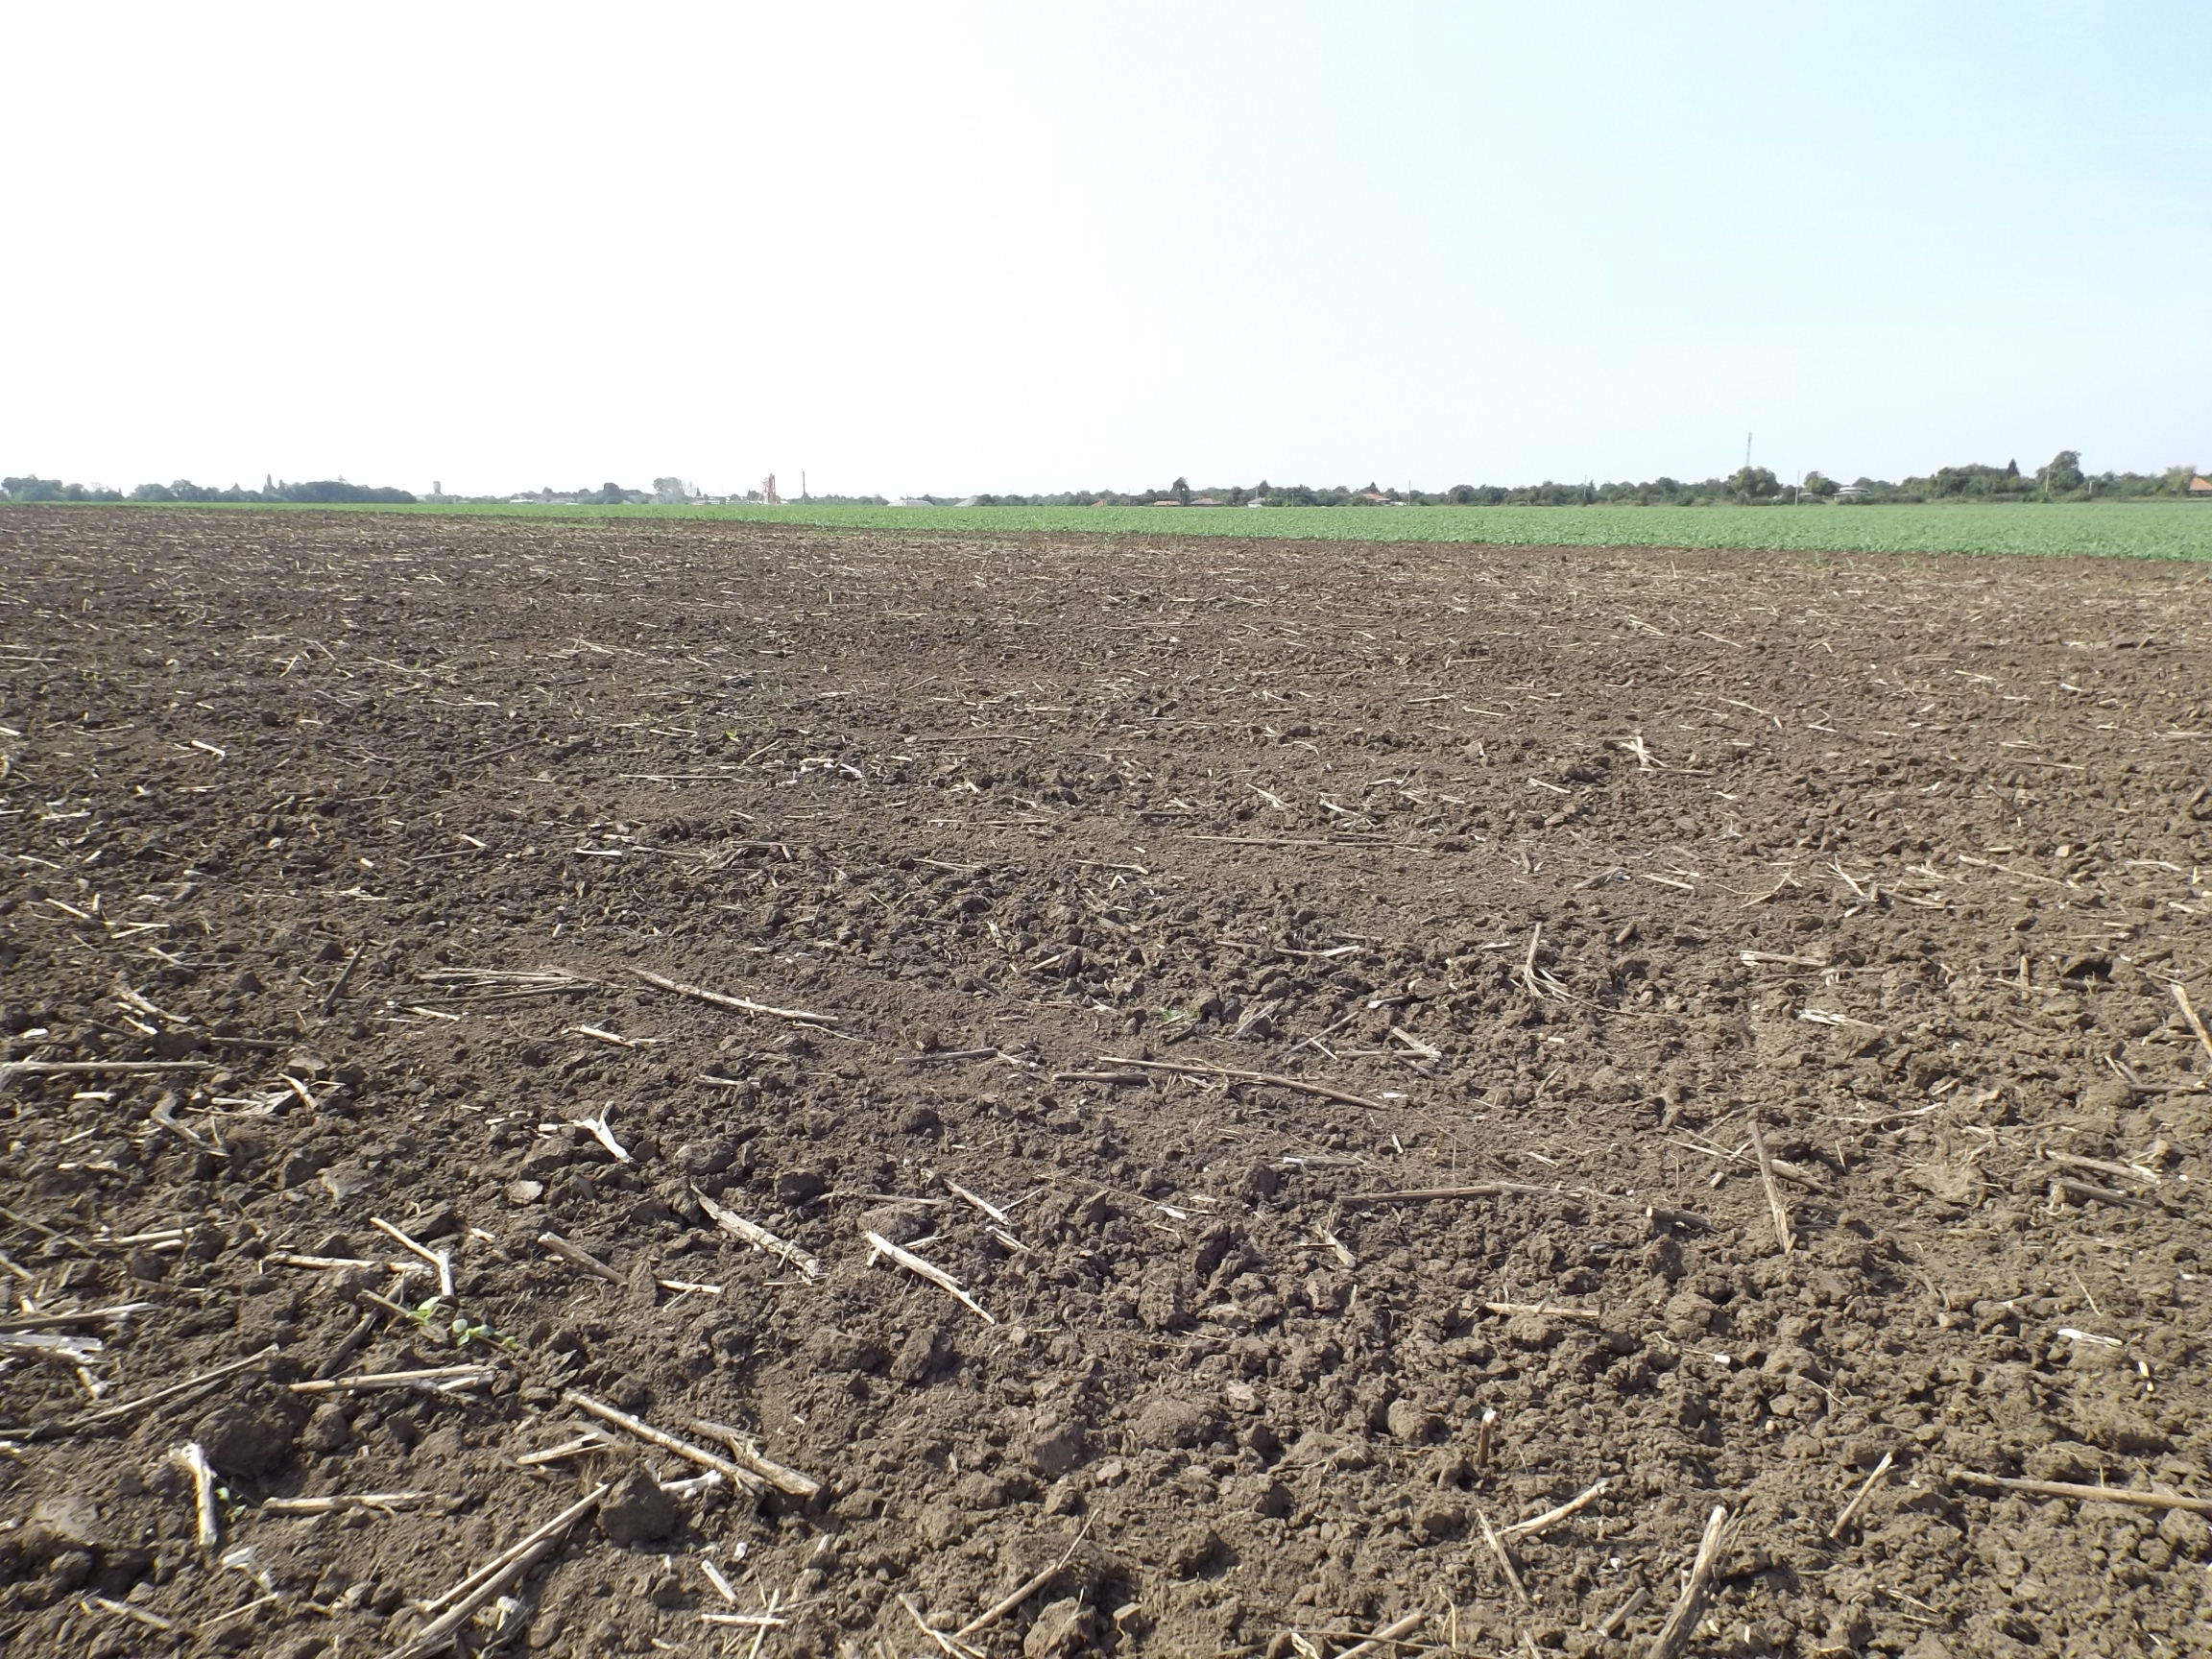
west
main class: Cropland
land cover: Sunflower
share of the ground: < 10 %
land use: Agriculture (excluding fallow land and kitchen gardens)
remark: Harvested field
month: September
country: BG
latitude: 43.9922
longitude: 26.8402
